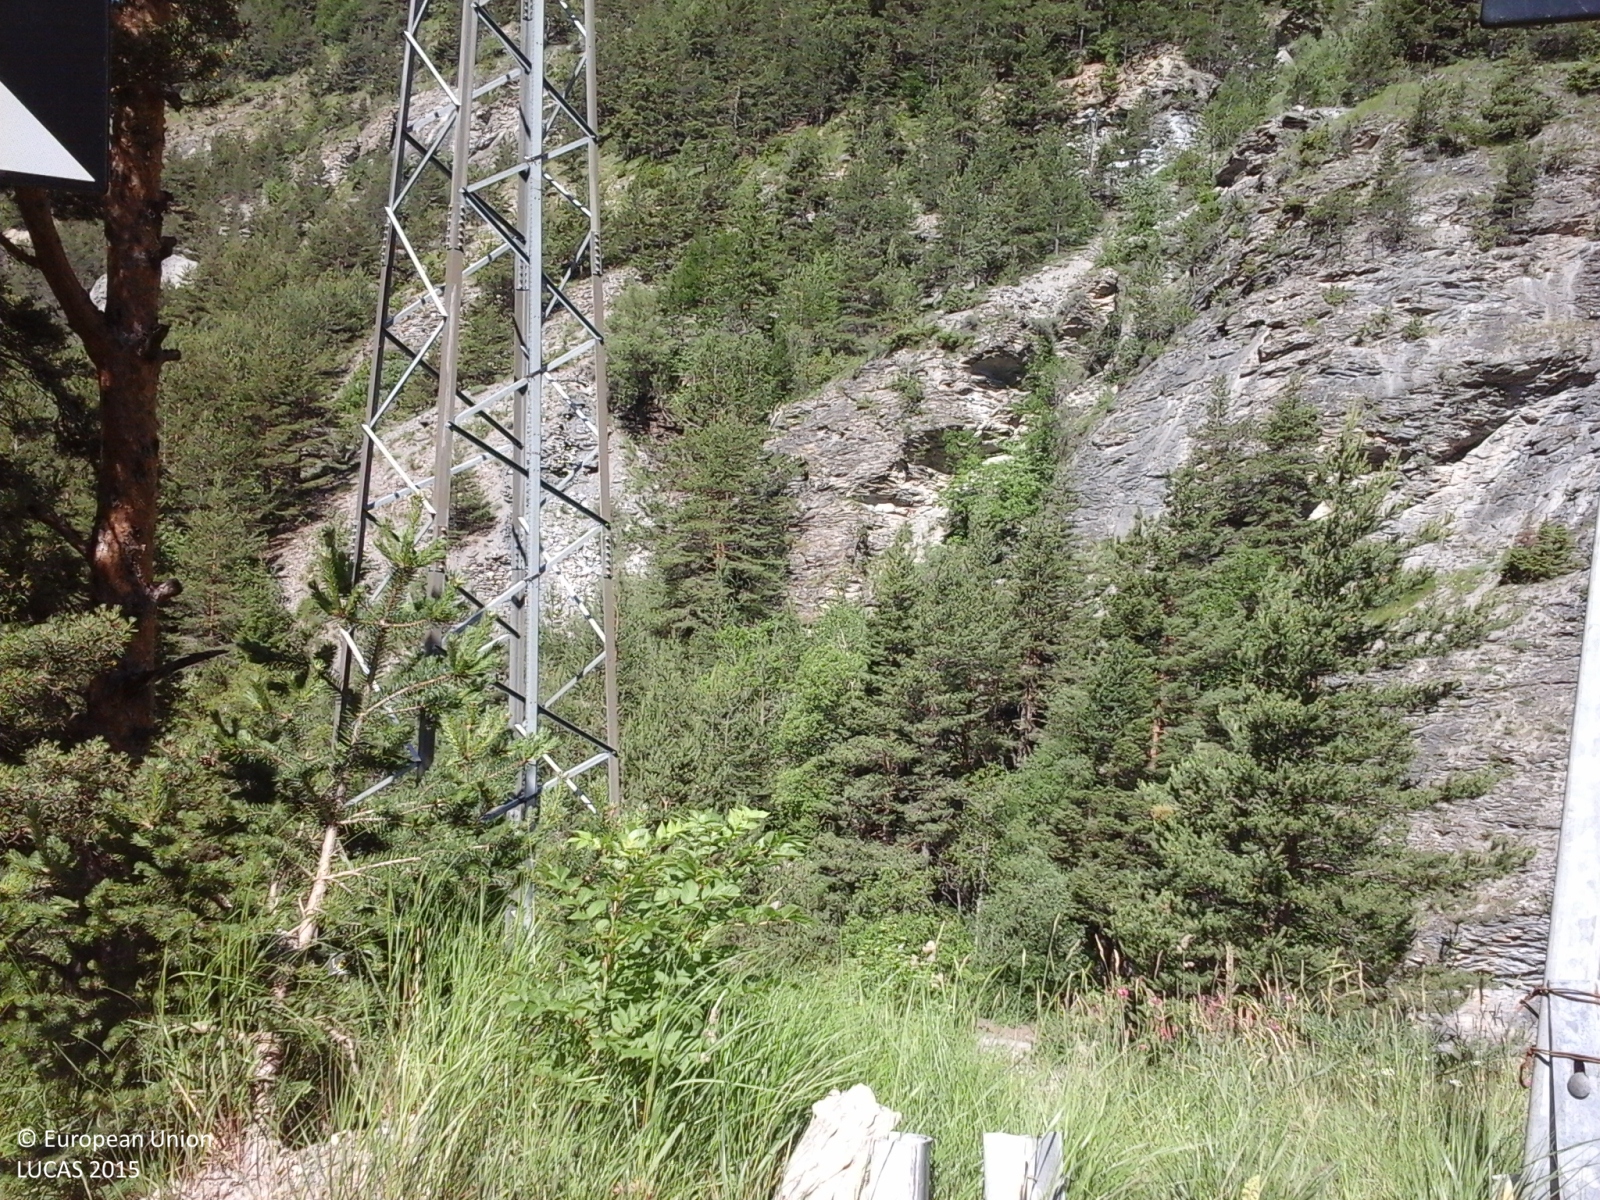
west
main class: Shrubland
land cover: Shrubland without tree cover
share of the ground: 10 - 25 %
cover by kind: herbaceous plants 40 %, consolidated bare surface 40 %, shrubs 20 %
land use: Semi-natural and natural areas not in use
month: June
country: IT
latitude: 45.0925
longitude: 6.7142
